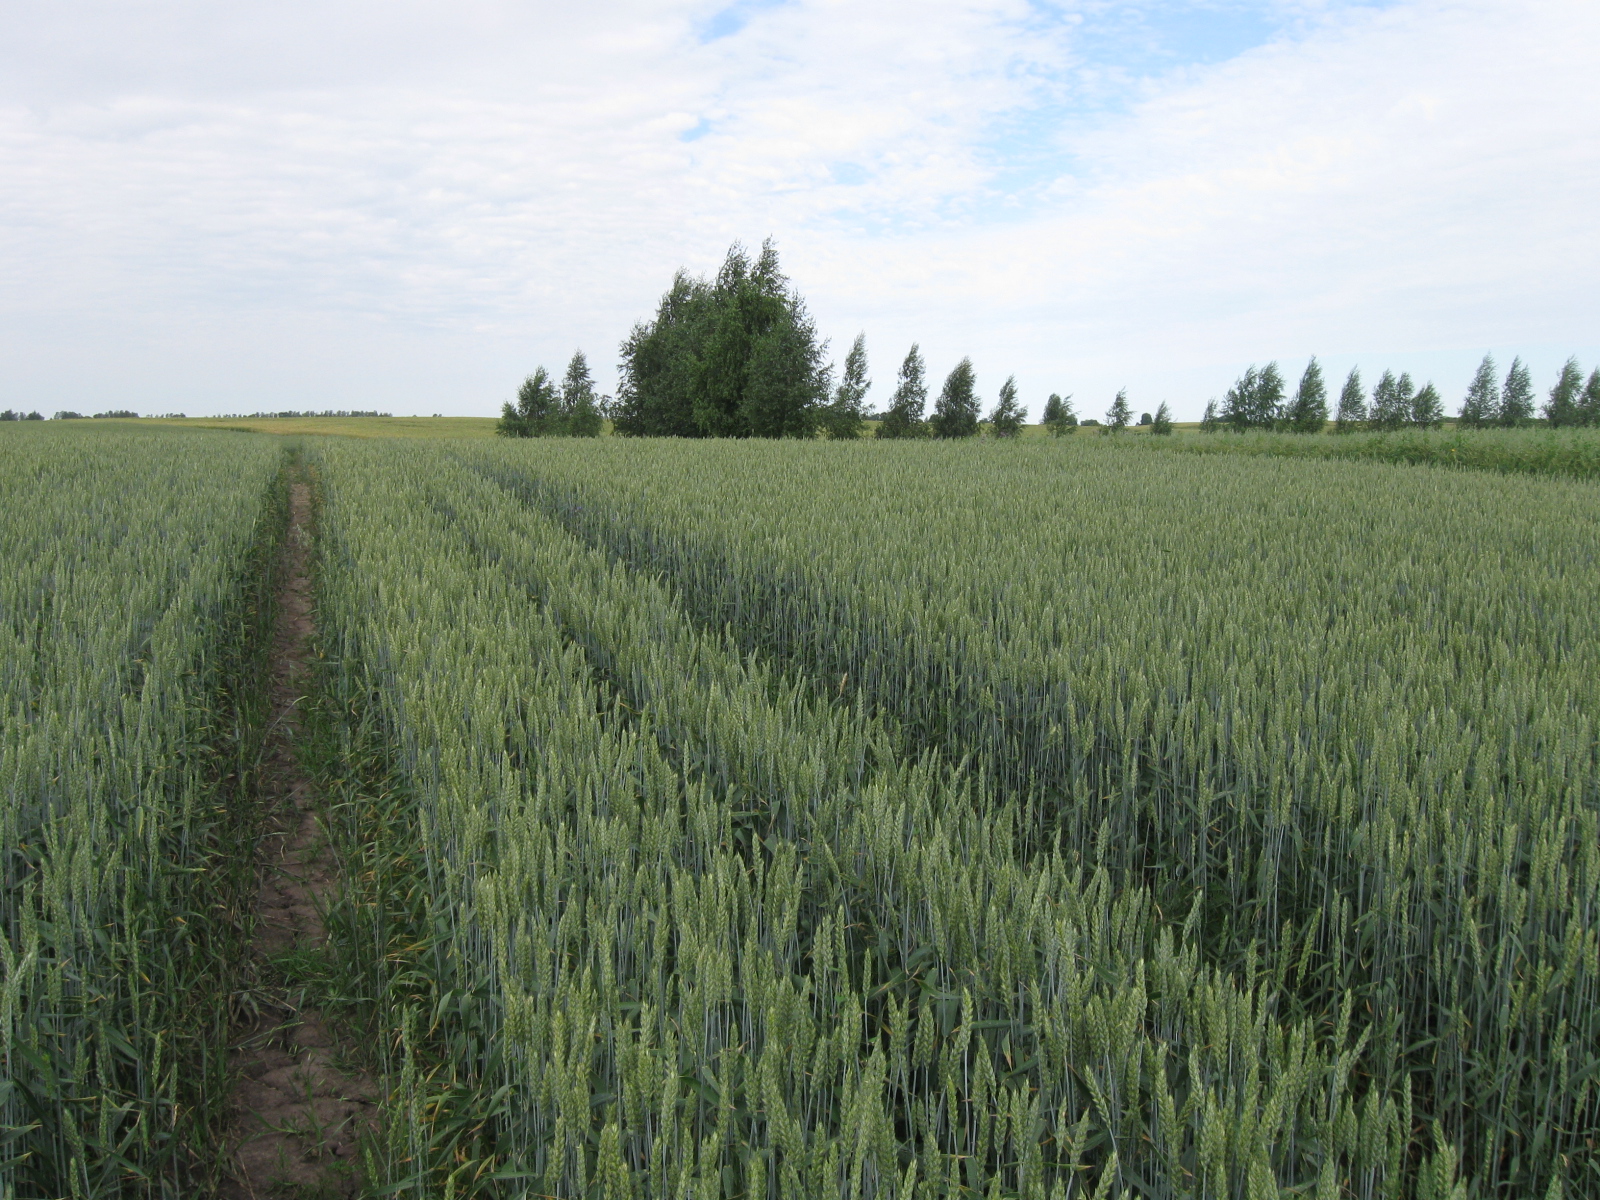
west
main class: Cropland
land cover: Common wheat
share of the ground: > 75 %
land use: Agriculture (excluding fallow land and kitchen gardens)
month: July
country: LT
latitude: 55.0338
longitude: 23.6487
